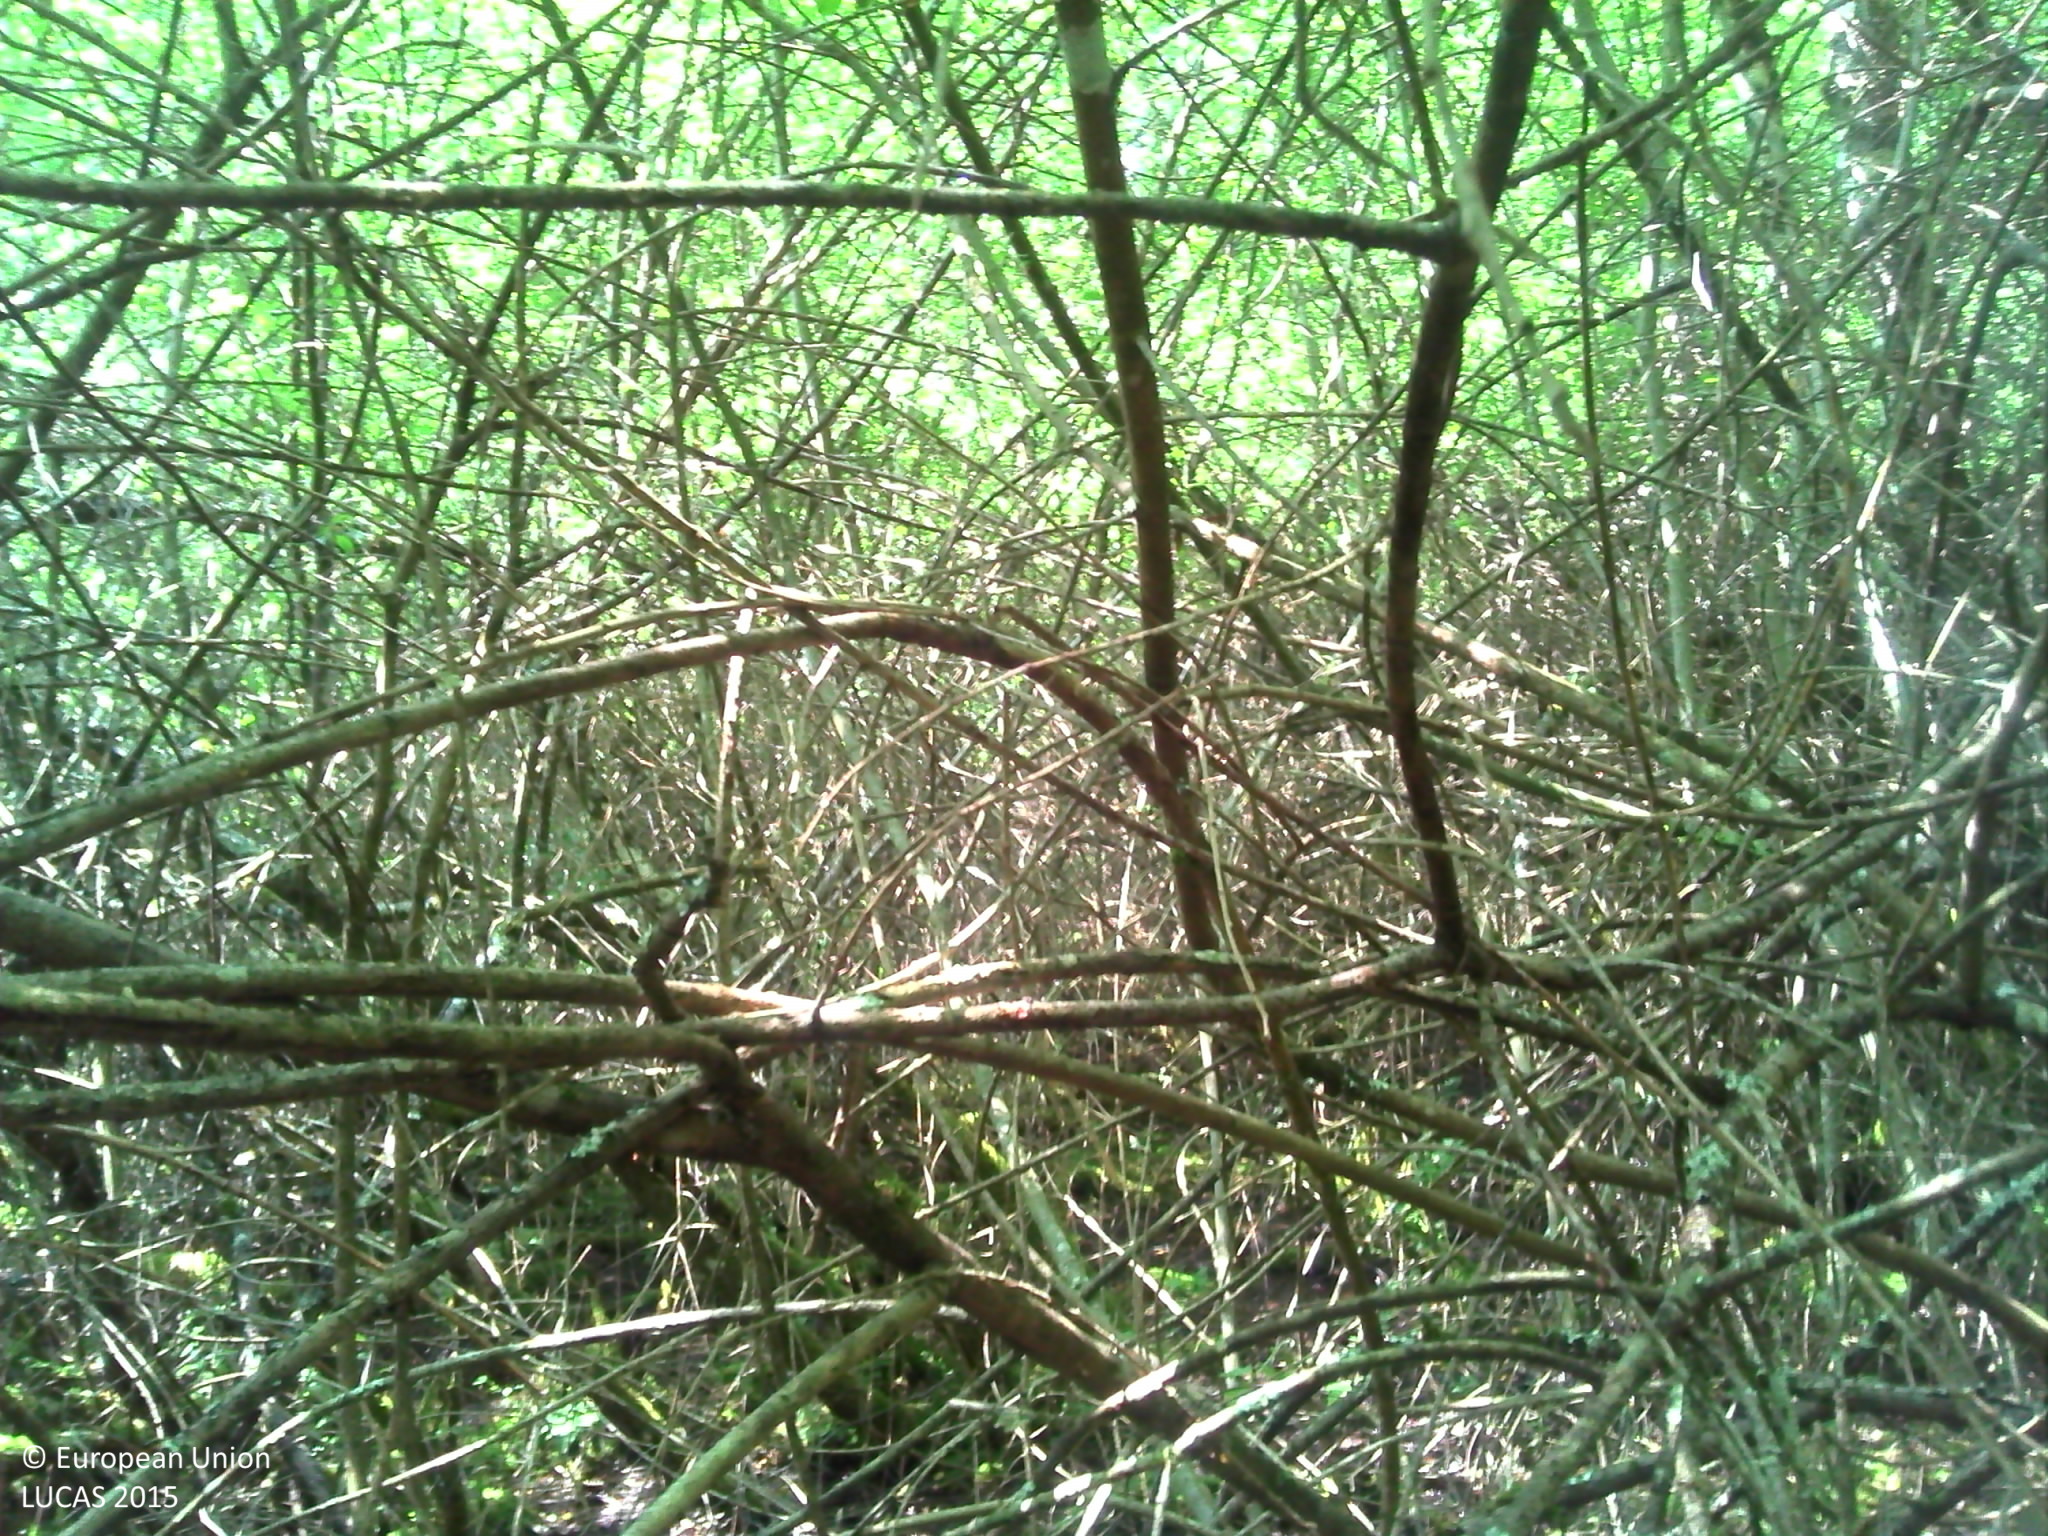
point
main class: Woodland
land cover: Broadleaved woodland
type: floodplain forest
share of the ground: > 75 %
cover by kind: broadleaved forest trees 60 %, lichens and mosses 20 %, shrubs 10 %, herbaceous plants 10 %
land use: Semi-natural and natural areas not in use
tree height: > 5 m
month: July
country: FR
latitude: 45.9814
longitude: 1.7967
